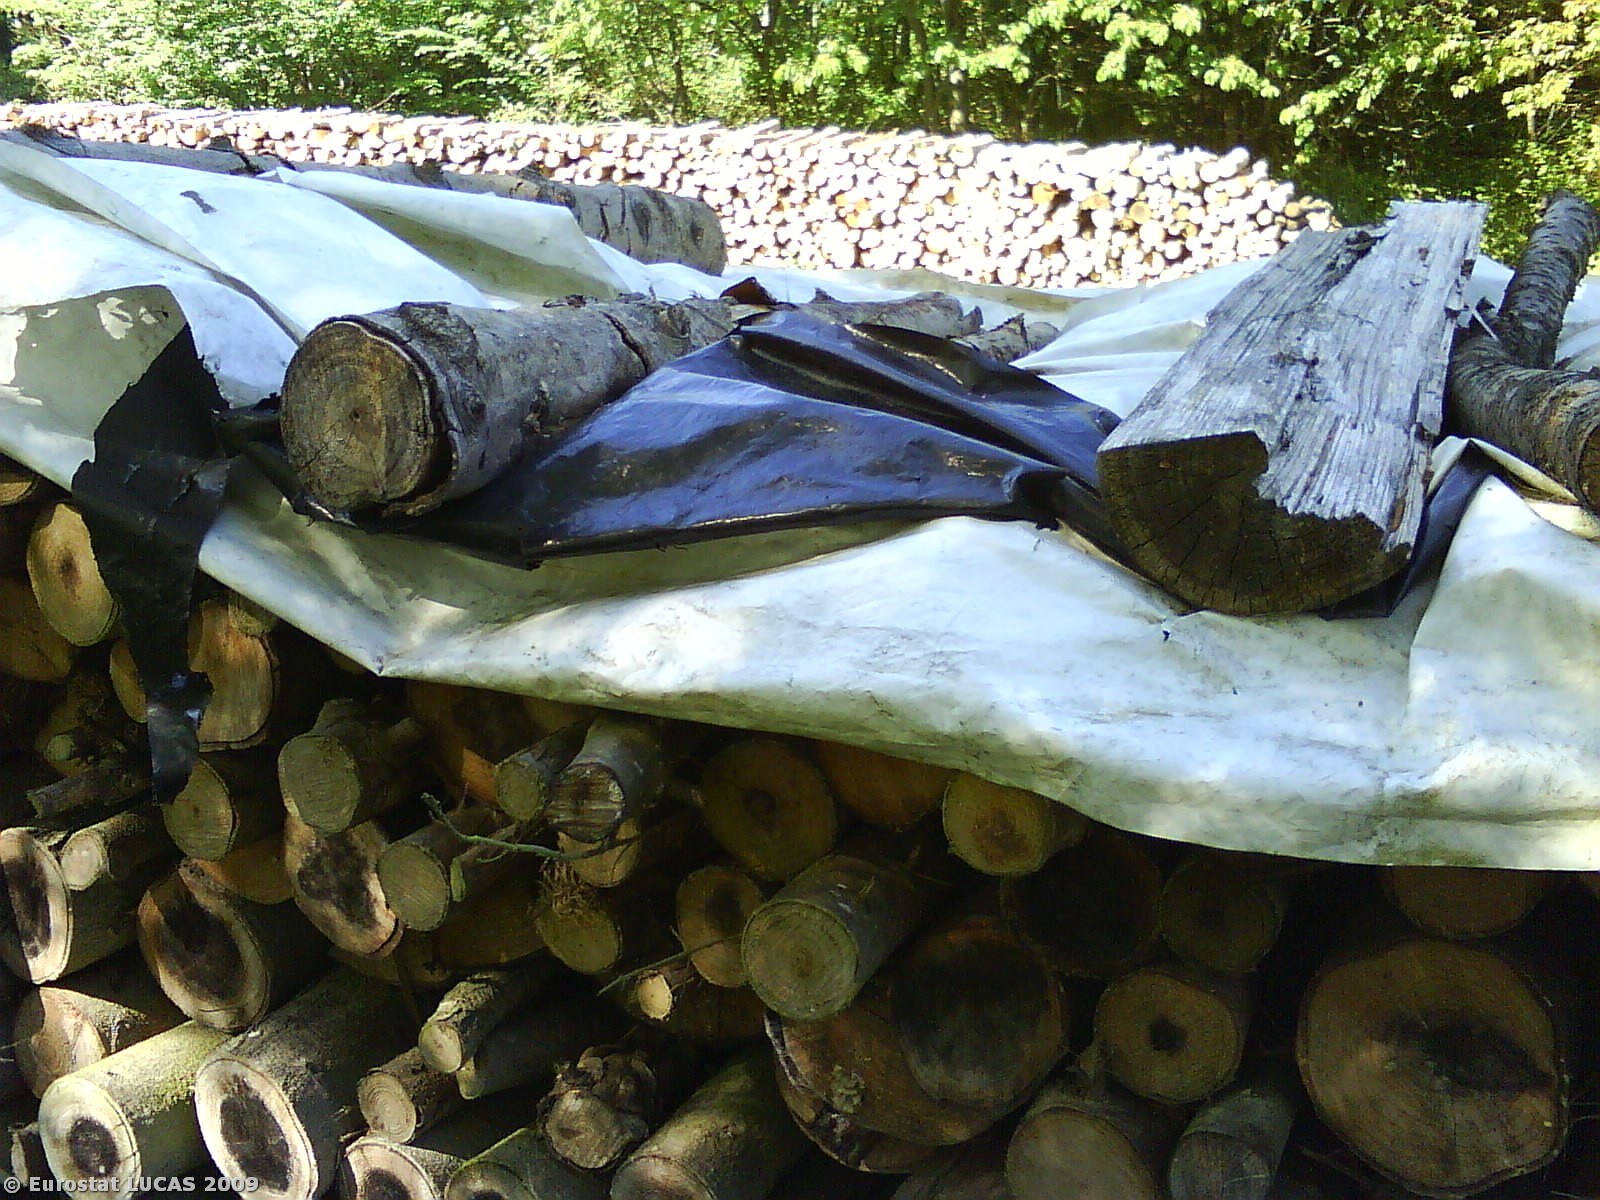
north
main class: Woodland
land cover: Broadleaved woodland
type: plantations and self-sown exotic forest
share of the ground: 25 - 50 %
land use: Forestry
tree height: > 5 m
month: May
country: DK
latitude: 56.4549
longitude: 10.7941
